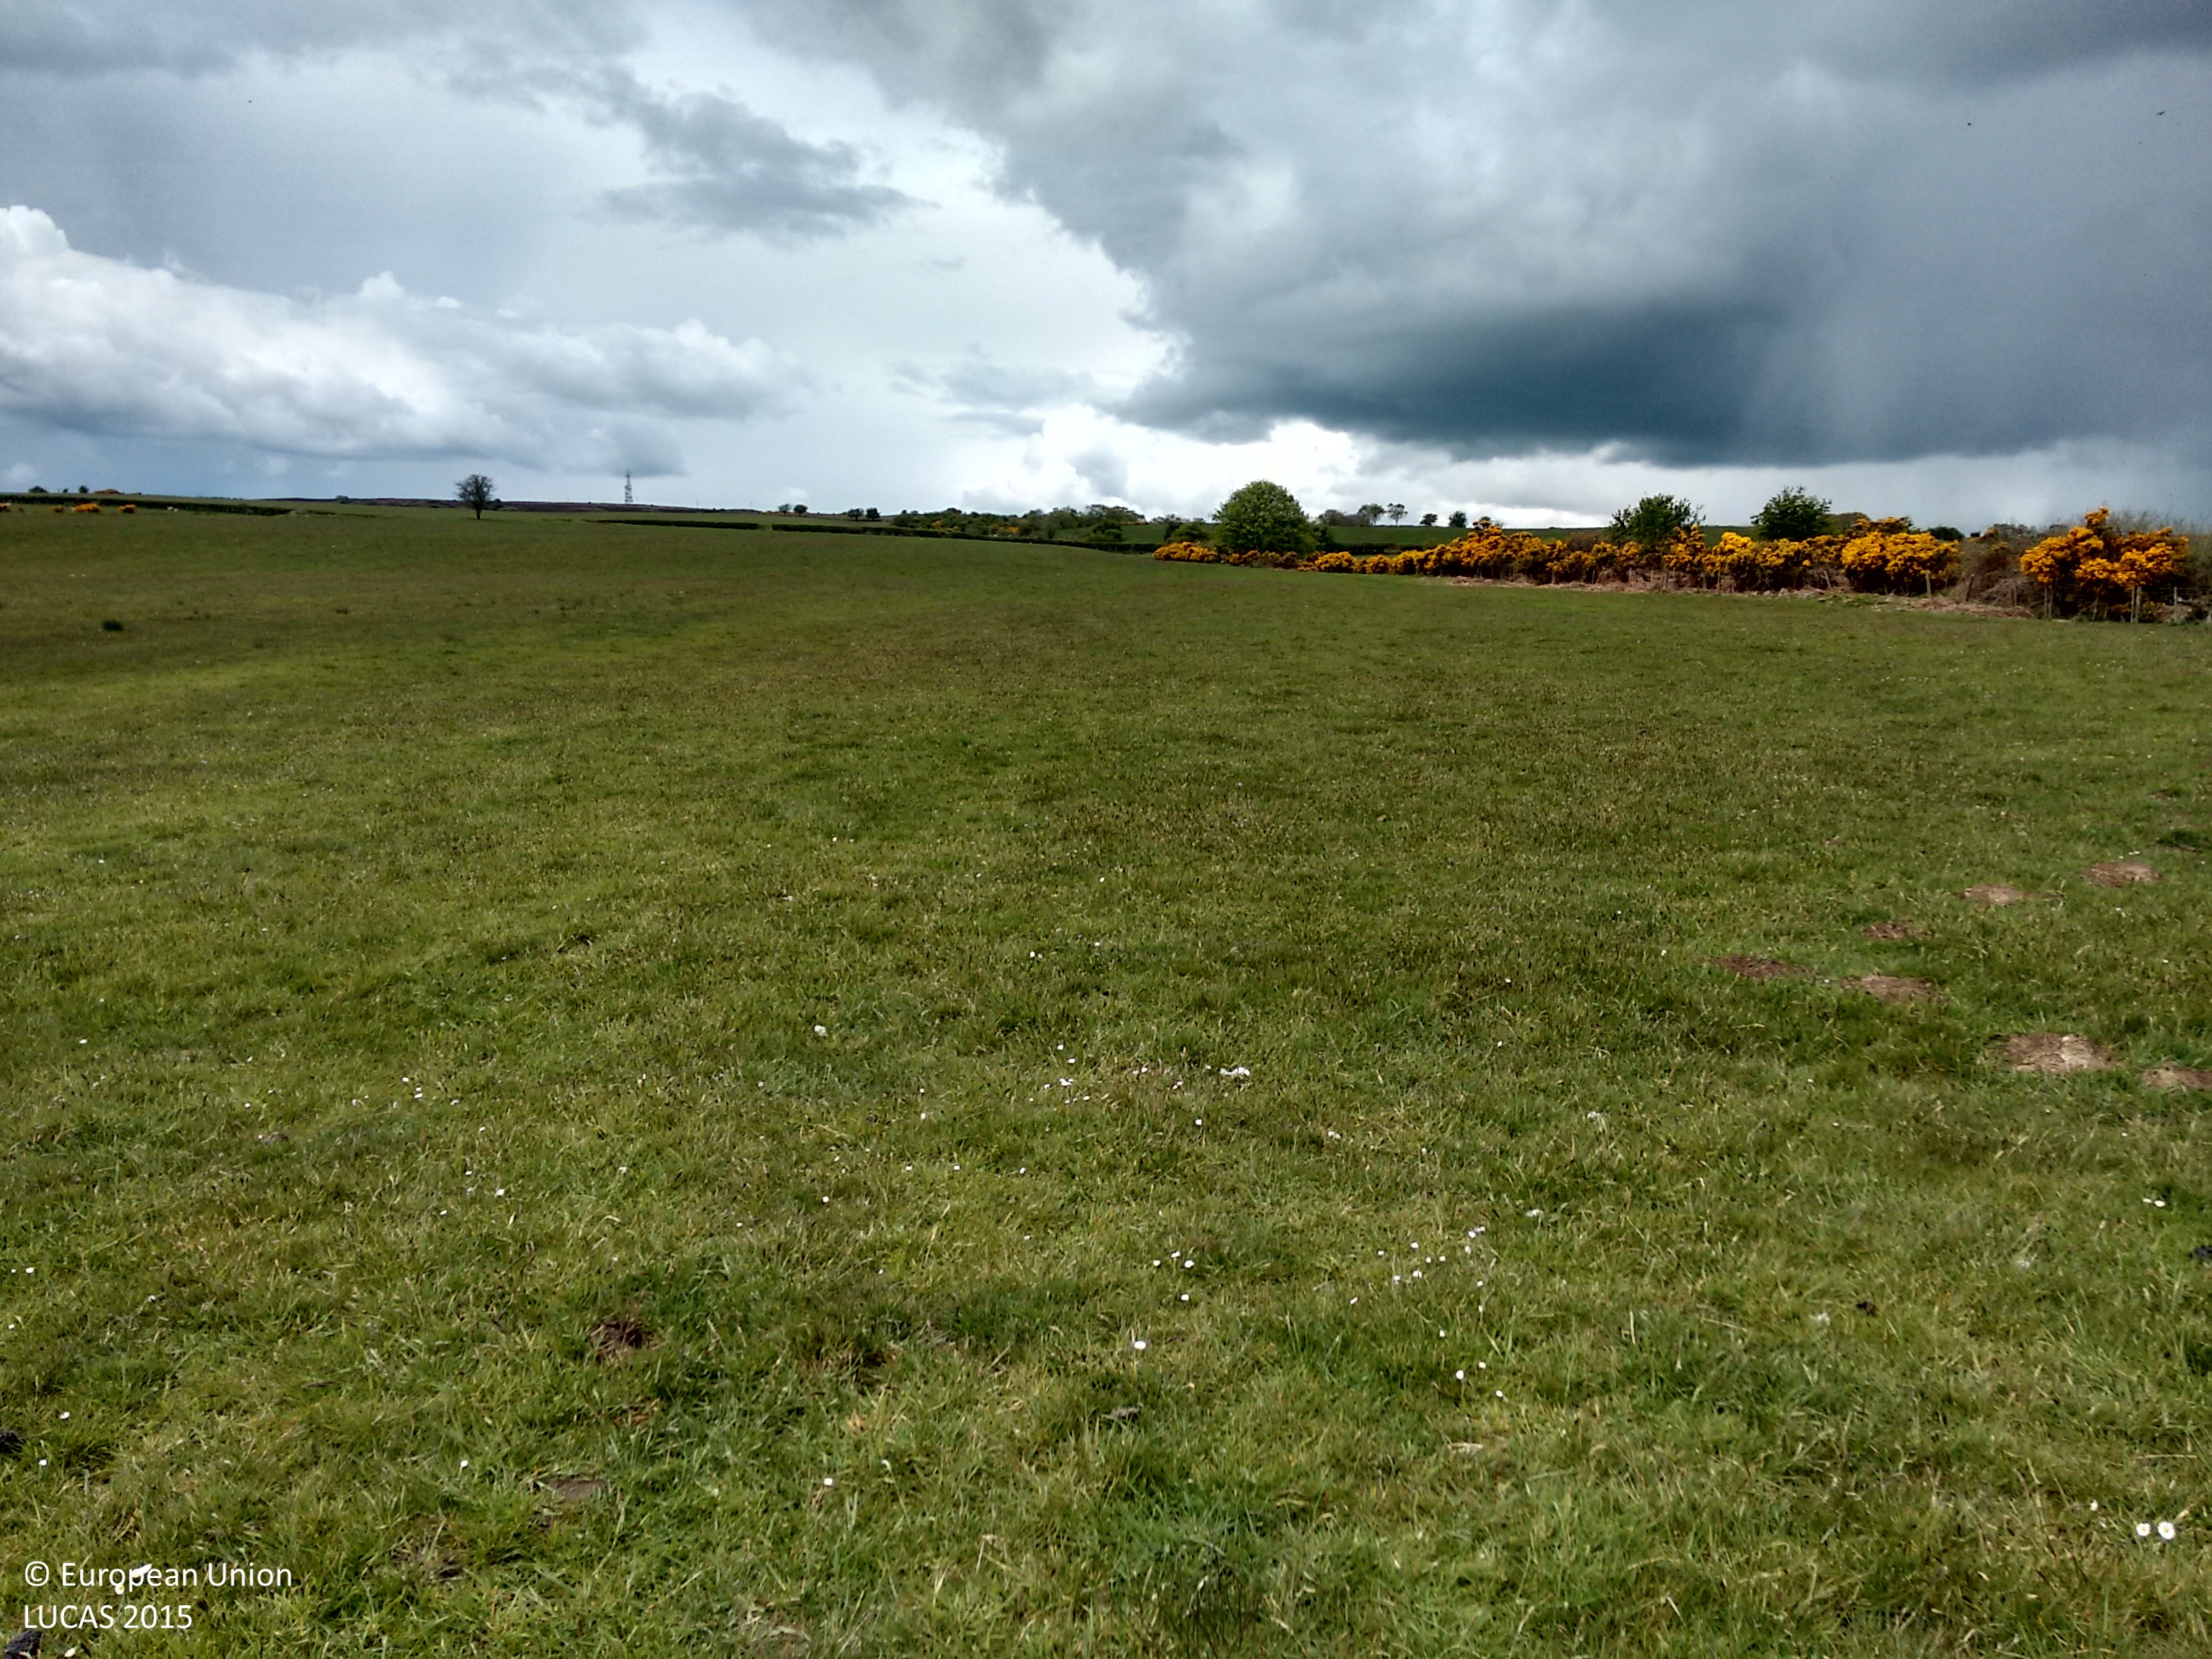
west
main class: Grassland
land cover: Grassland without tree/shrub cover
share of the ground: > 75 %
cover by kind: herbaceous plants 100 %
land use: Agriculture (excluding fallow land and kitchen gardens)
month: May
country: GB
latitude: 55.3913
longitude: -1.7480
